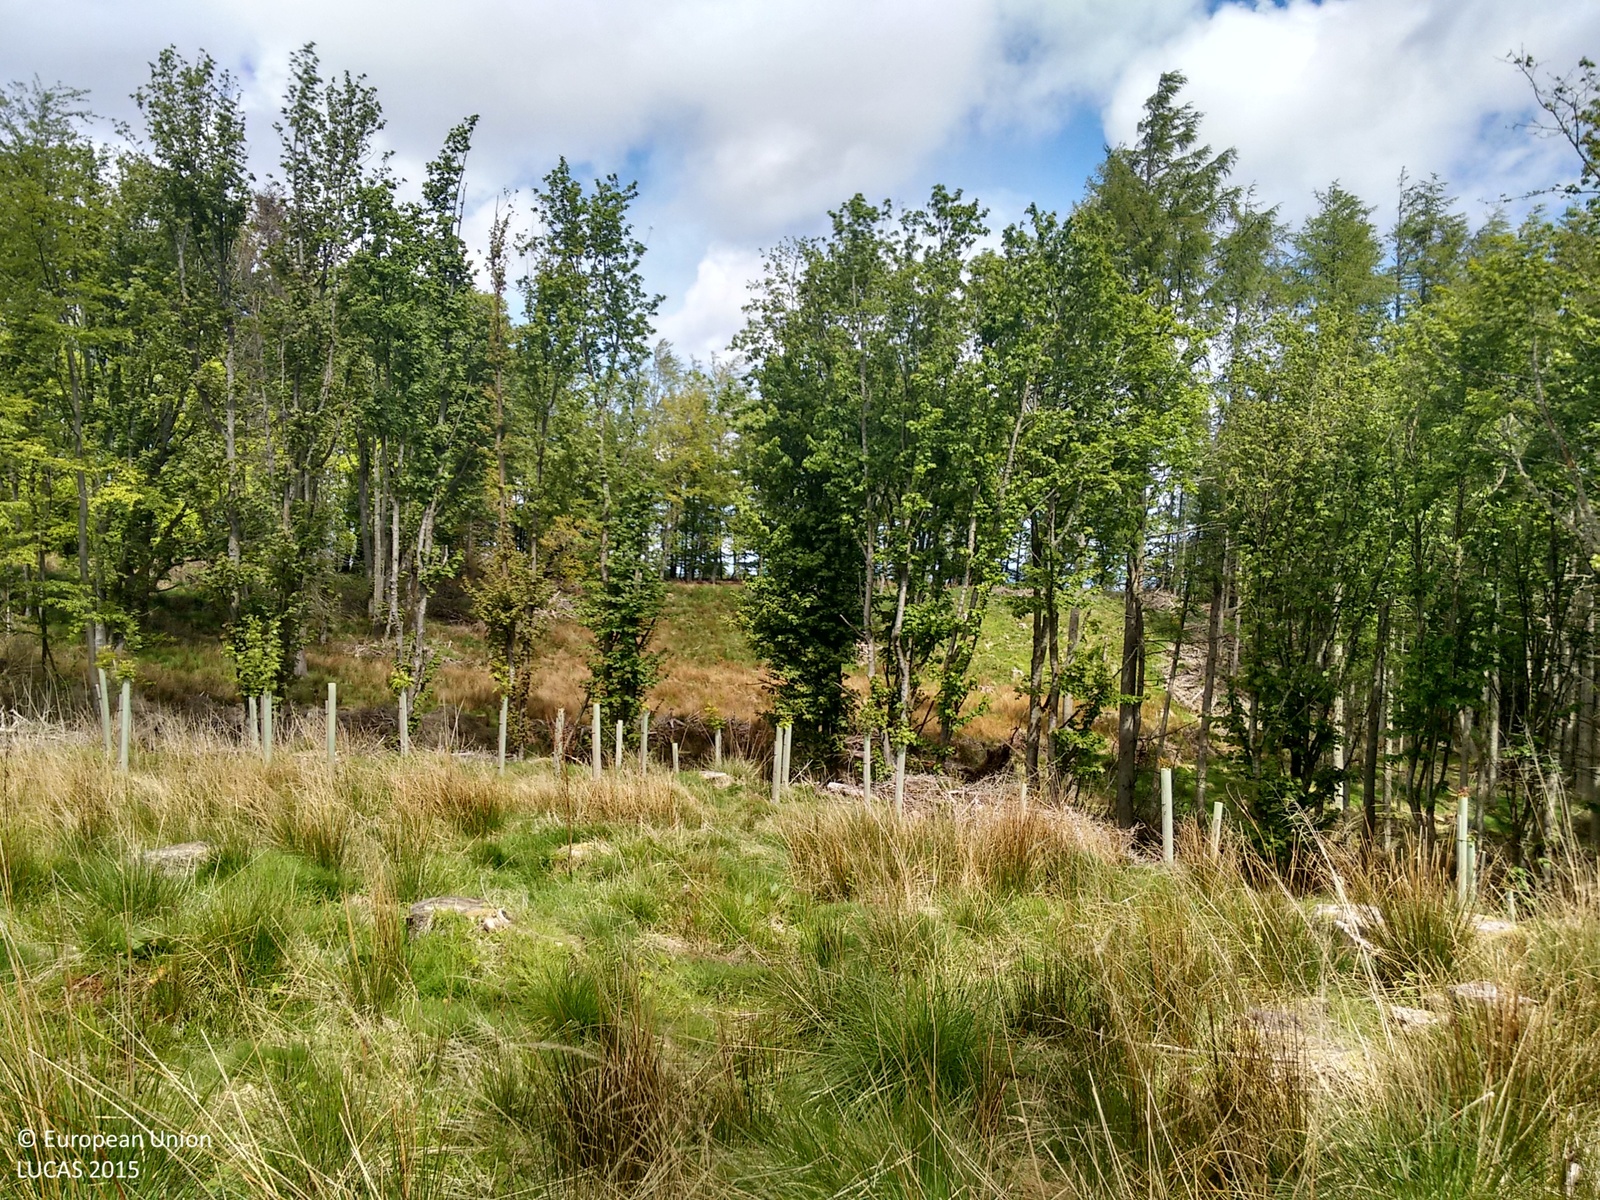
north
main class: Grassland
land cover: Grassland with sparse tree/shrub cover
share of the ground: > 75 %
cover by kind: herbaceous plants 85 %, broadleaved forest trees 5 %
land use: Forestry
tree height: > 5 m
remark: Clear cut
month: May
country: GB
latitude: 55.9380
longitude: -2.4985
